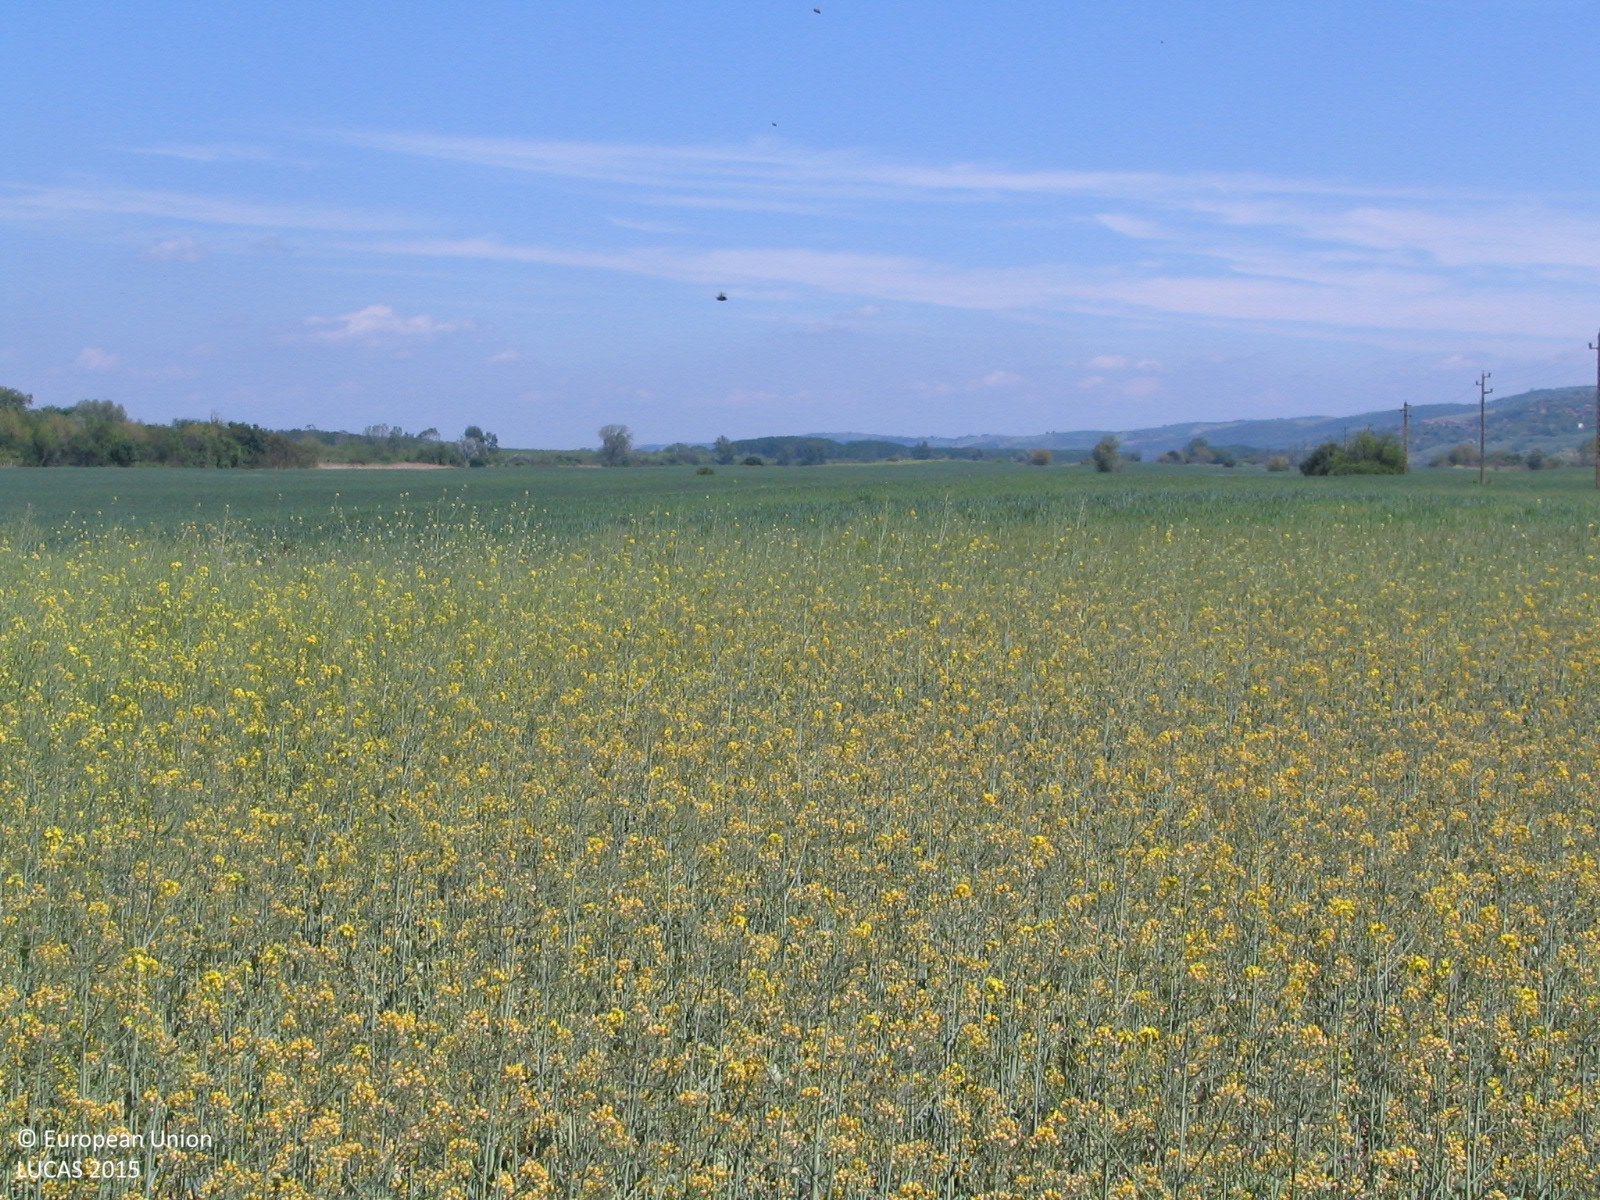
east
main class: Cropland
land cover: Rape and turnip rape
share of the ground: > 75 %
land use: Agriculture (excluding fallow land and kitchen gardens)
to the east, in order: Rape and turnip rape; Grass margins; Common wheat
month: May
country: BG
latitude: 43.6946
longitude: 24.0889
